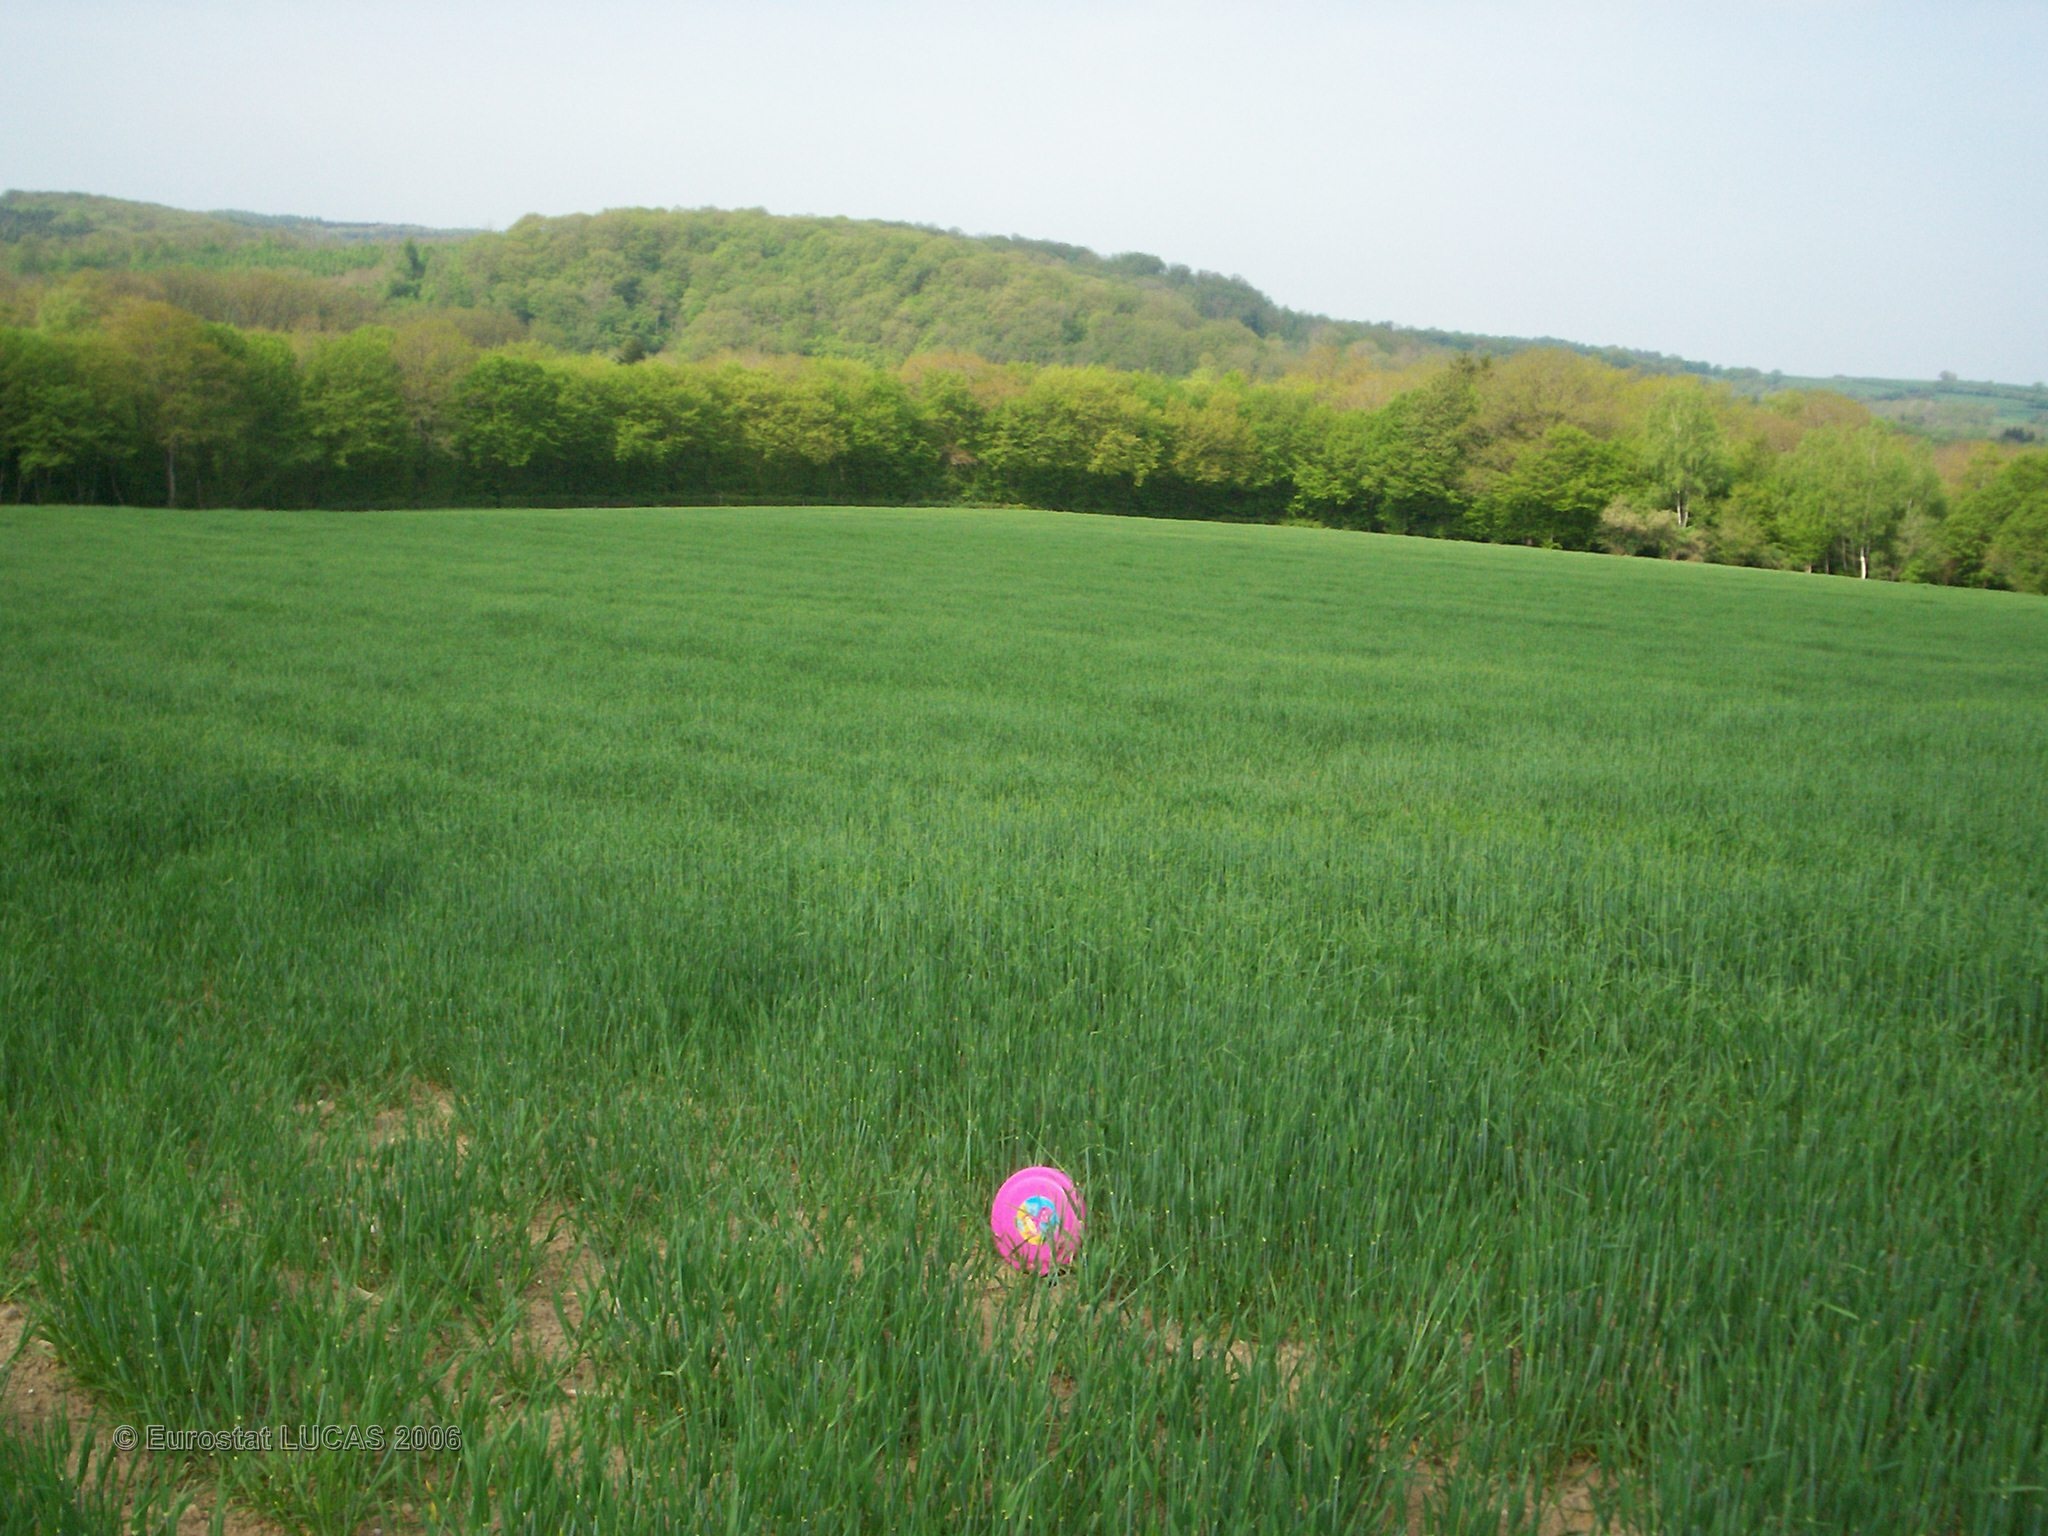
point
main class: Cropland
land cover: Barley
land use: Agriculture (excluding fallow land and kitchen gardens)
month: May
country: FR
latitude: 47.4295
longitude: 4.0189
